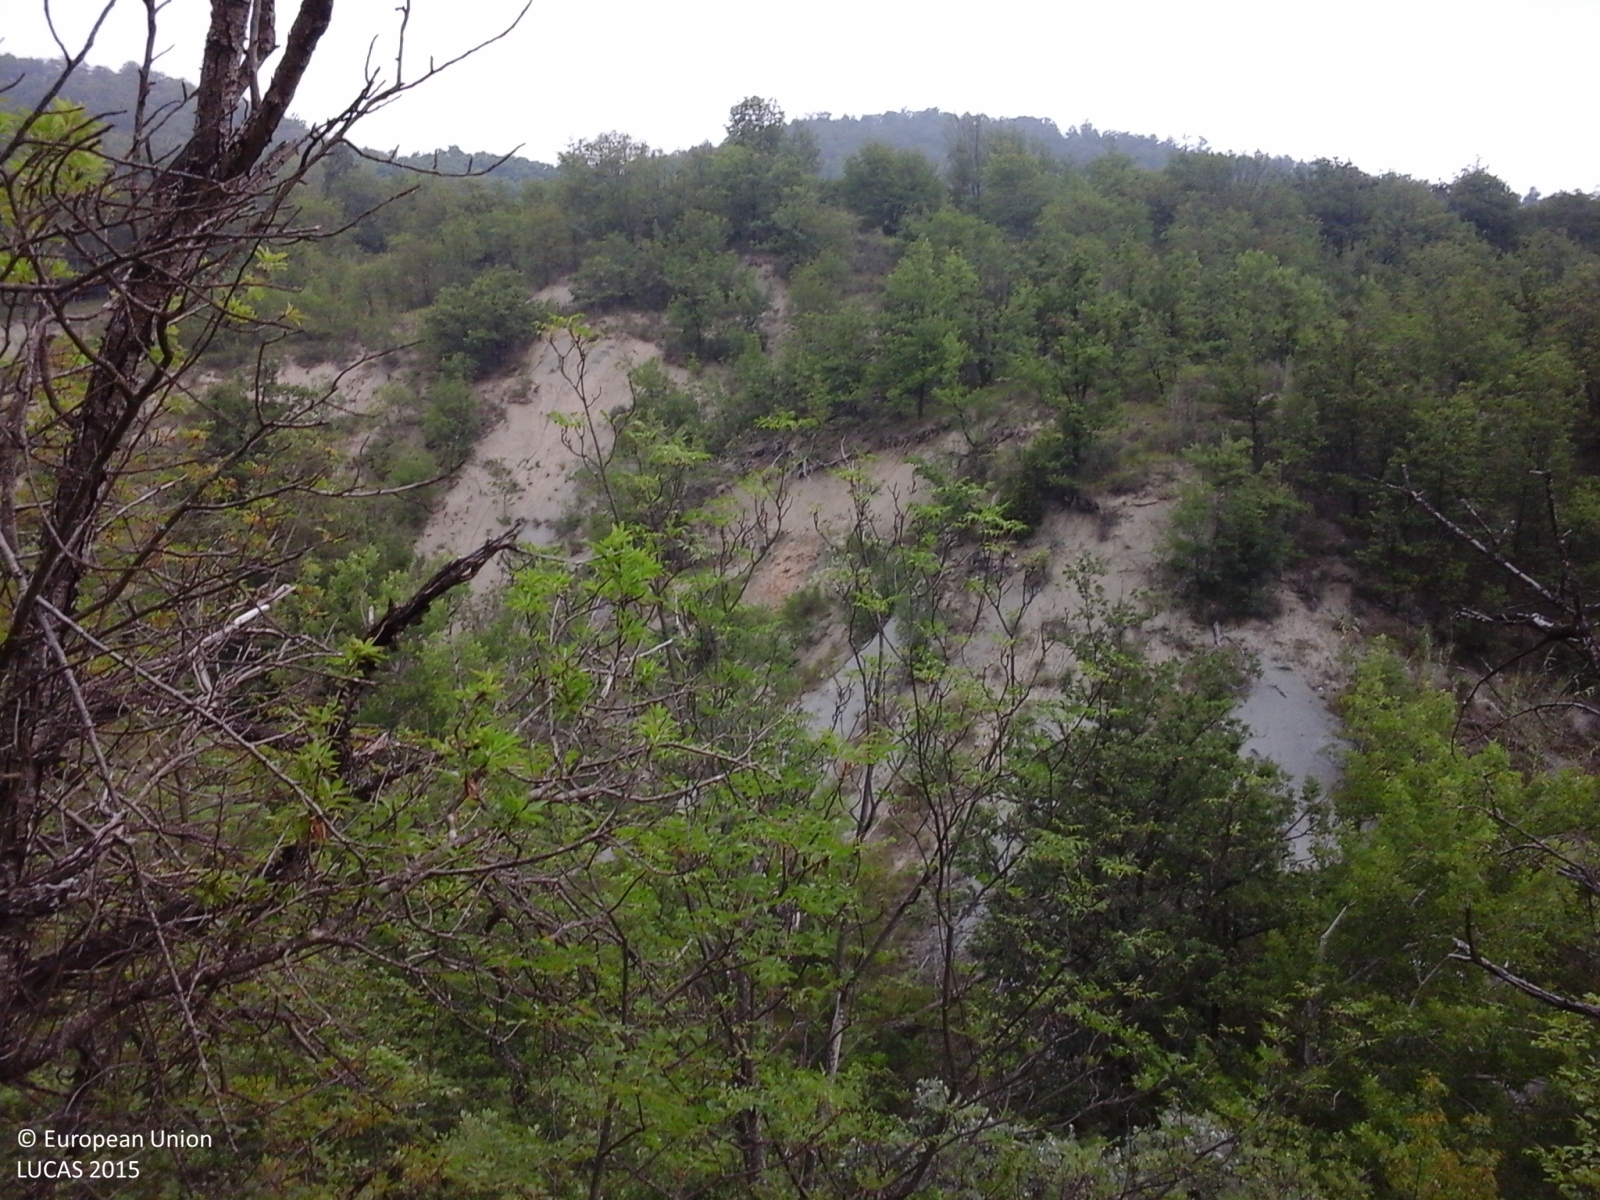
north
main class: Woodland
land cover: Broadleaved woodland
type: thermophilous deciduous forest
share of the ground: > 75 %
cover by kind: broadleaved forest trees 65 %, herbaceous plants 25 %, shrubs 10 %
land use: Forestry
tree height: < 5 m
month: June
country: IT
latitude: 44.6107
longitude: 8.5288
